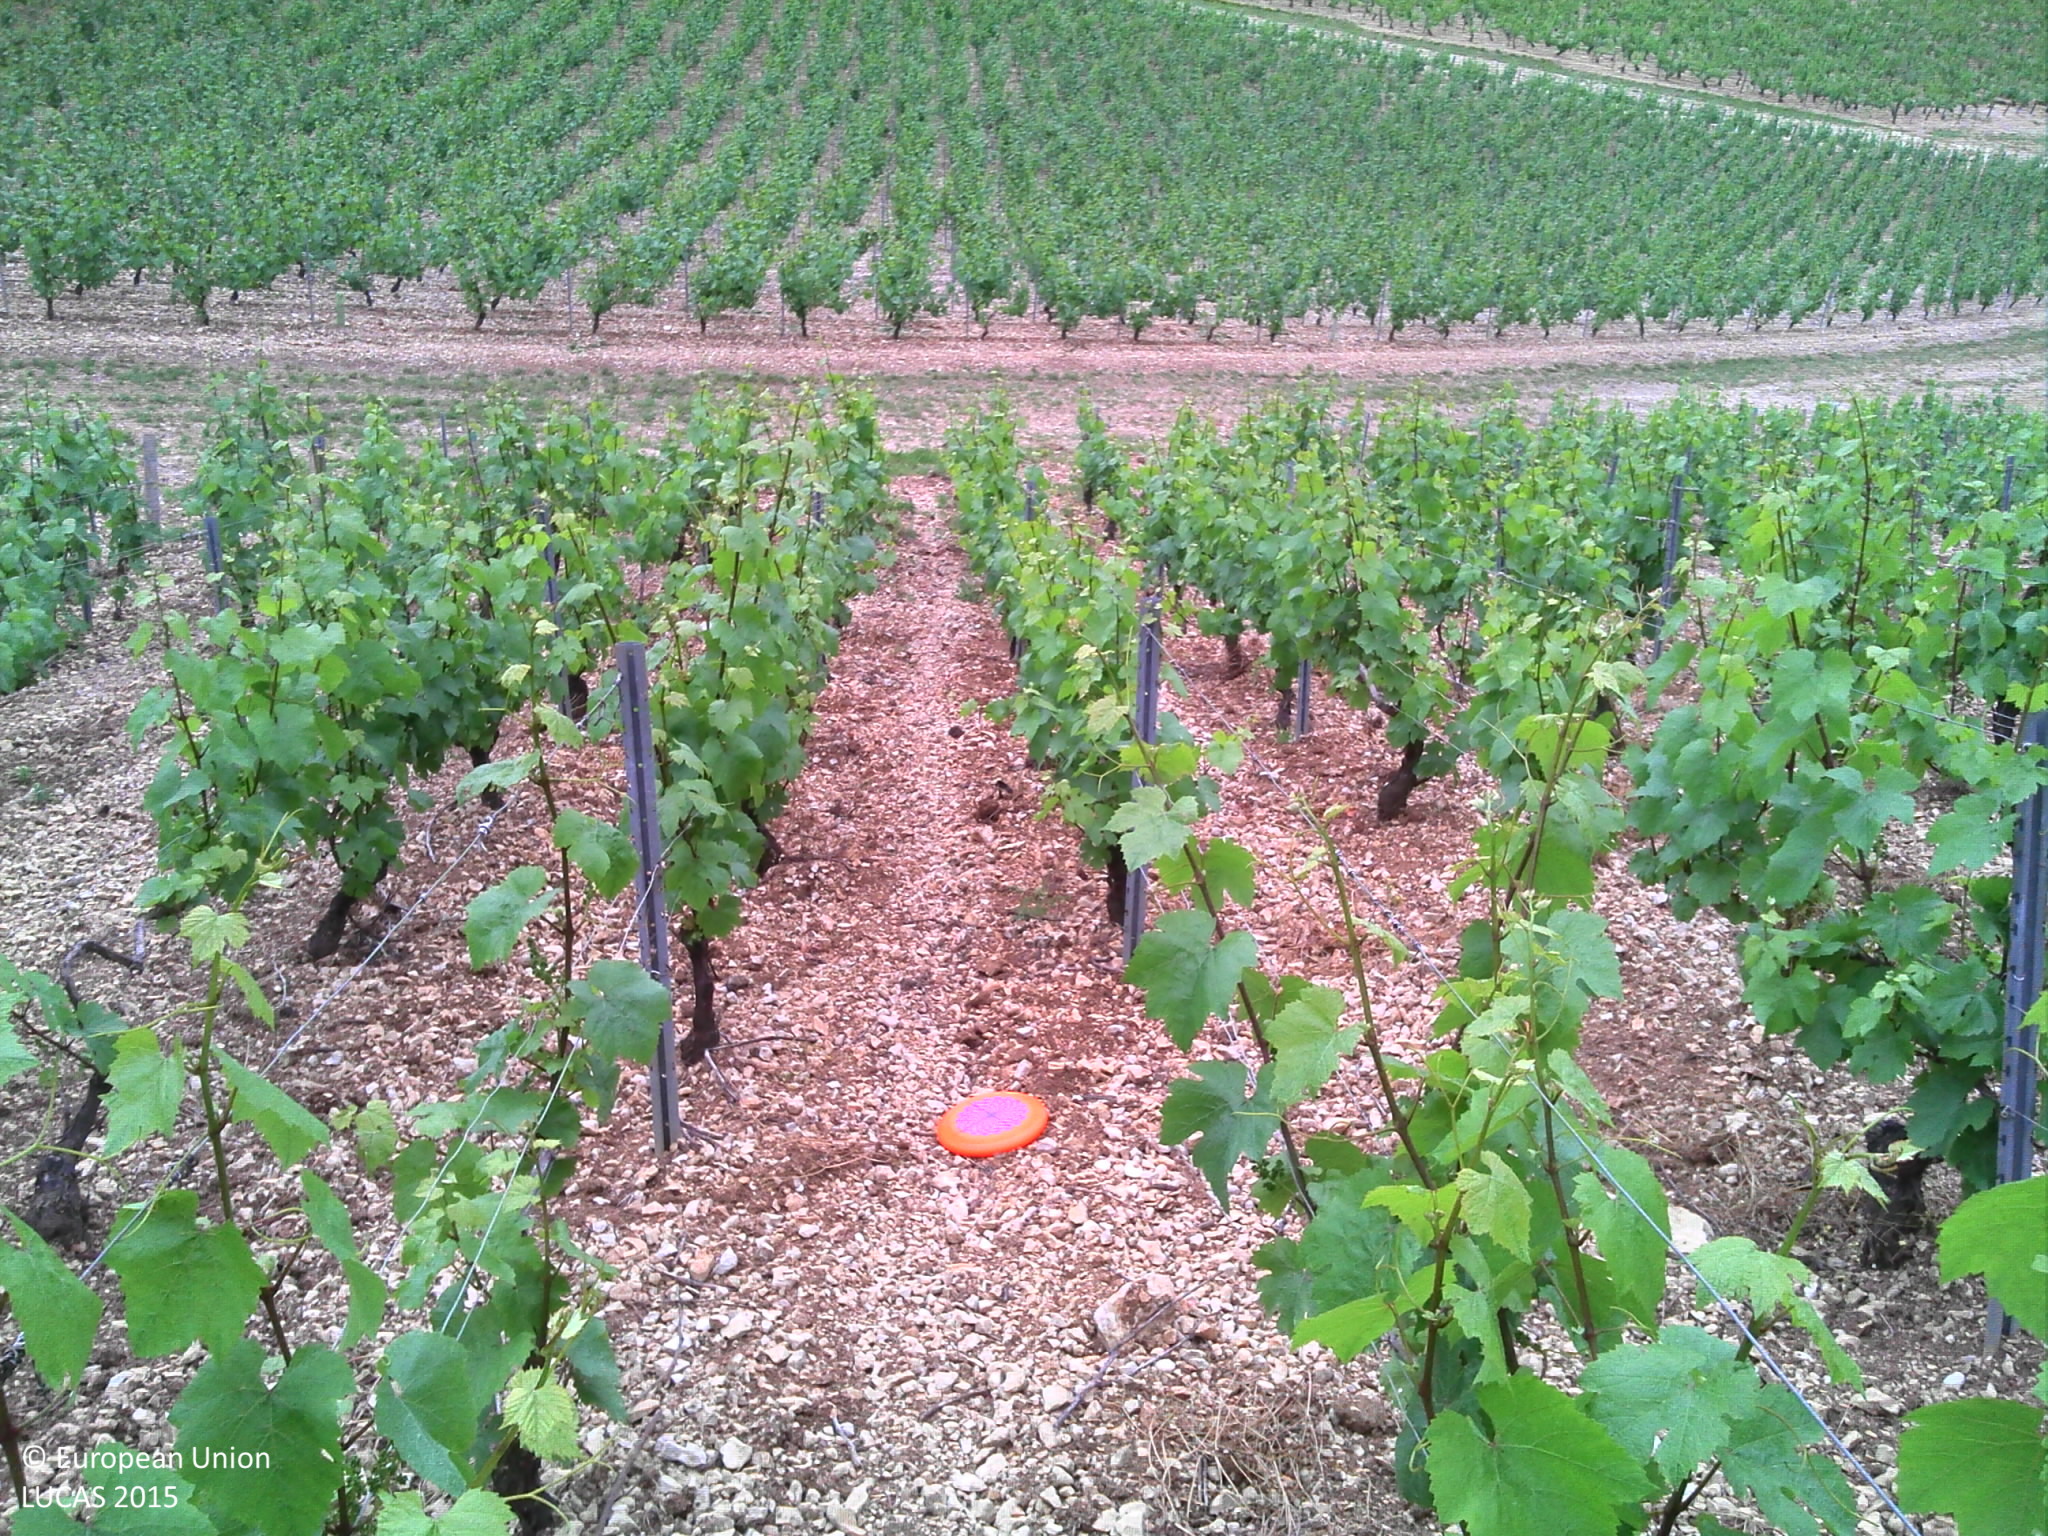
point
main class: Cropland
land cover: Vineyards
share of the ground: > 75 %
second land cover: Other bare soil
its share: > 75 %
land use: Agriculture (excluding fallow land and kitchen gardens)
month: May
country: FR
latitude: 47.8166
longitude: 3.8397
